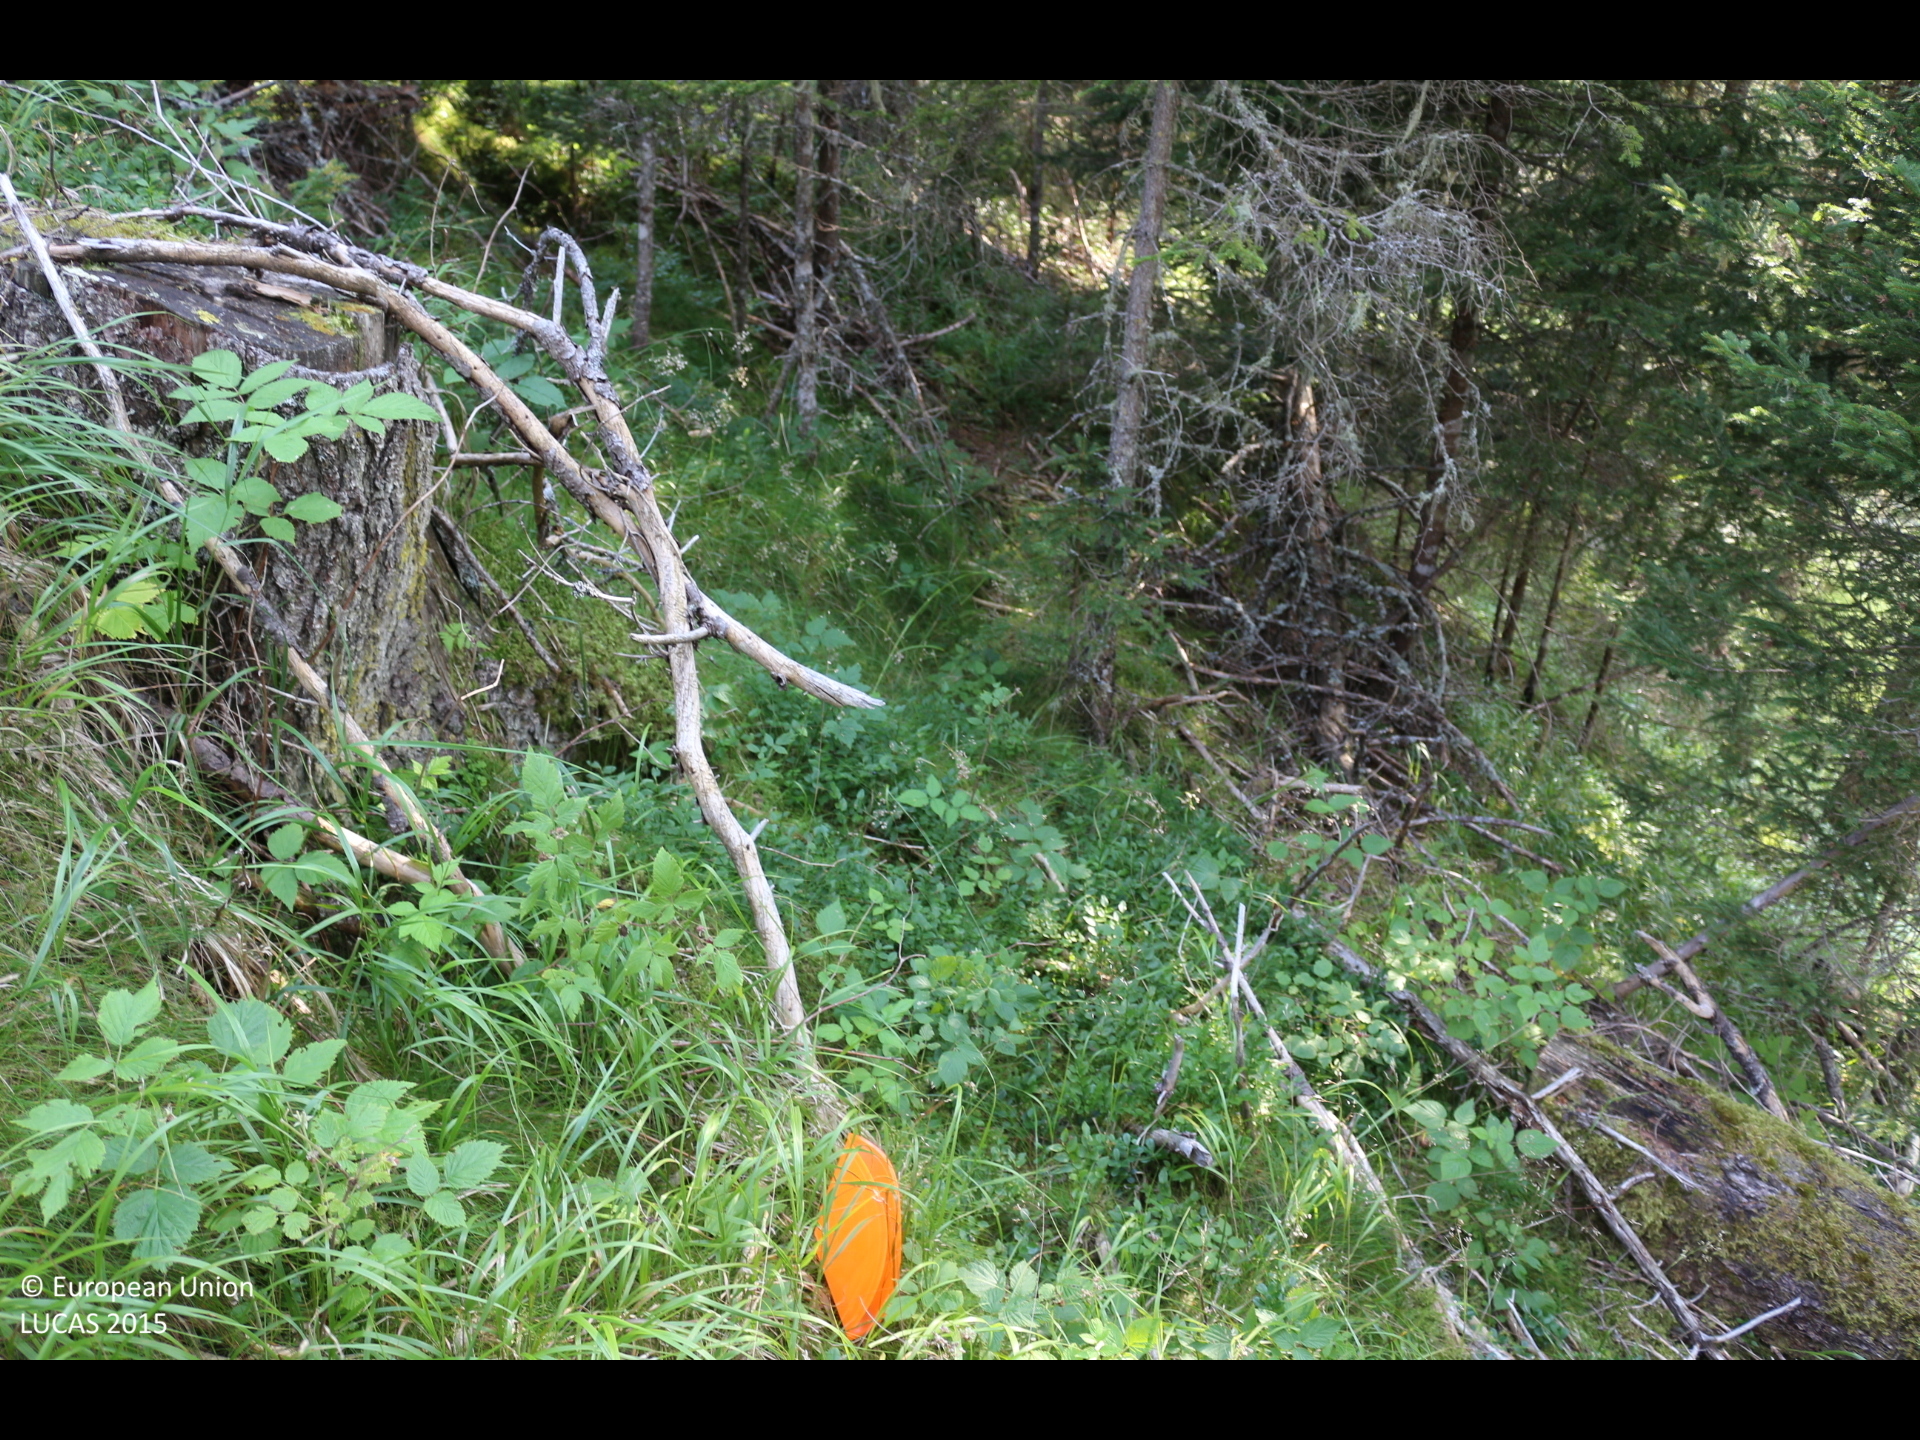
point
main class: Woodland
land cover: Spruce dominated coniferous woodland
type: alpine coniferous forest
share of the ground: > 75 %
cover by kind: coniferous forest trees 90 %, shrubs 5 %, lichens and mosses 5 %
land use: Forestry
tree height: > 5 m
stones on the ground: 10 - 25 %
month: August
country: AT
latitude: 46.9793
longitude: 14.0074
